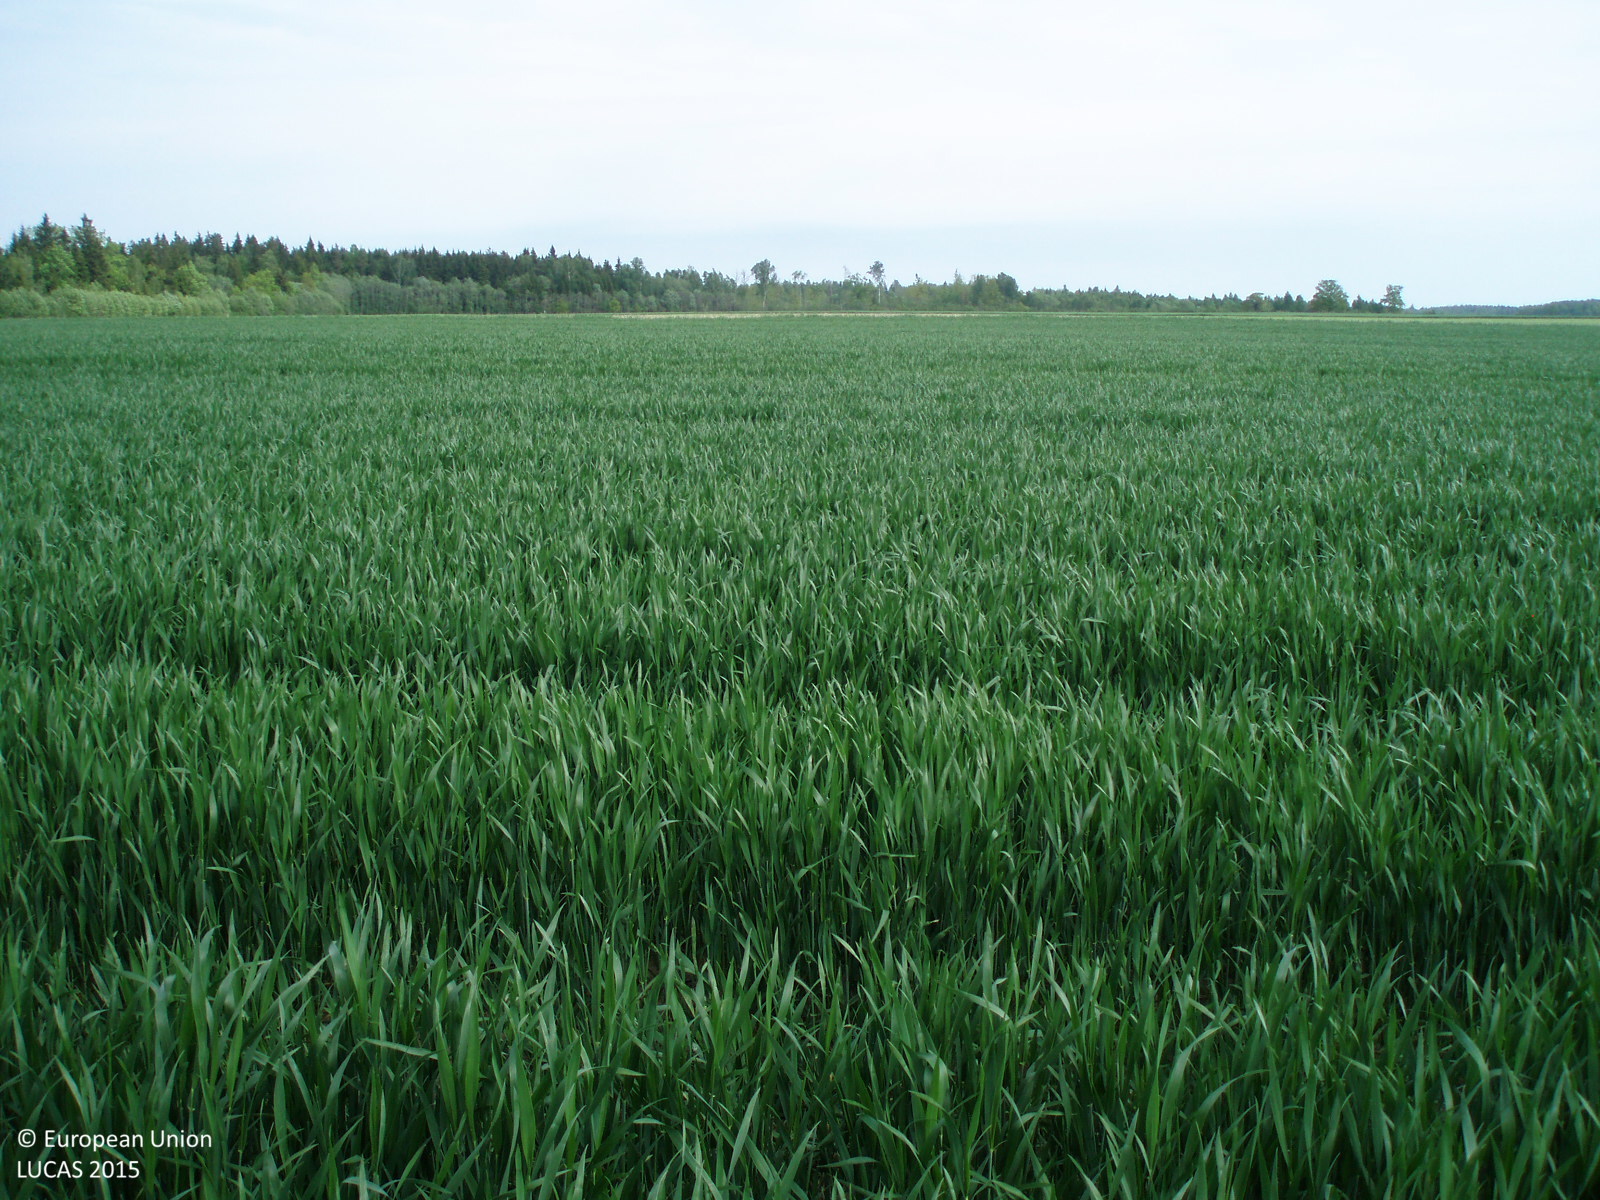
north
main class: Cropland
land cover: Common wheat
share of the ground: > 75 %
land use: Agriculture (excluding fallow land and kitchen gardens)
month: May
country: LT
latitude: 56.1831
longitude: 22.4143
